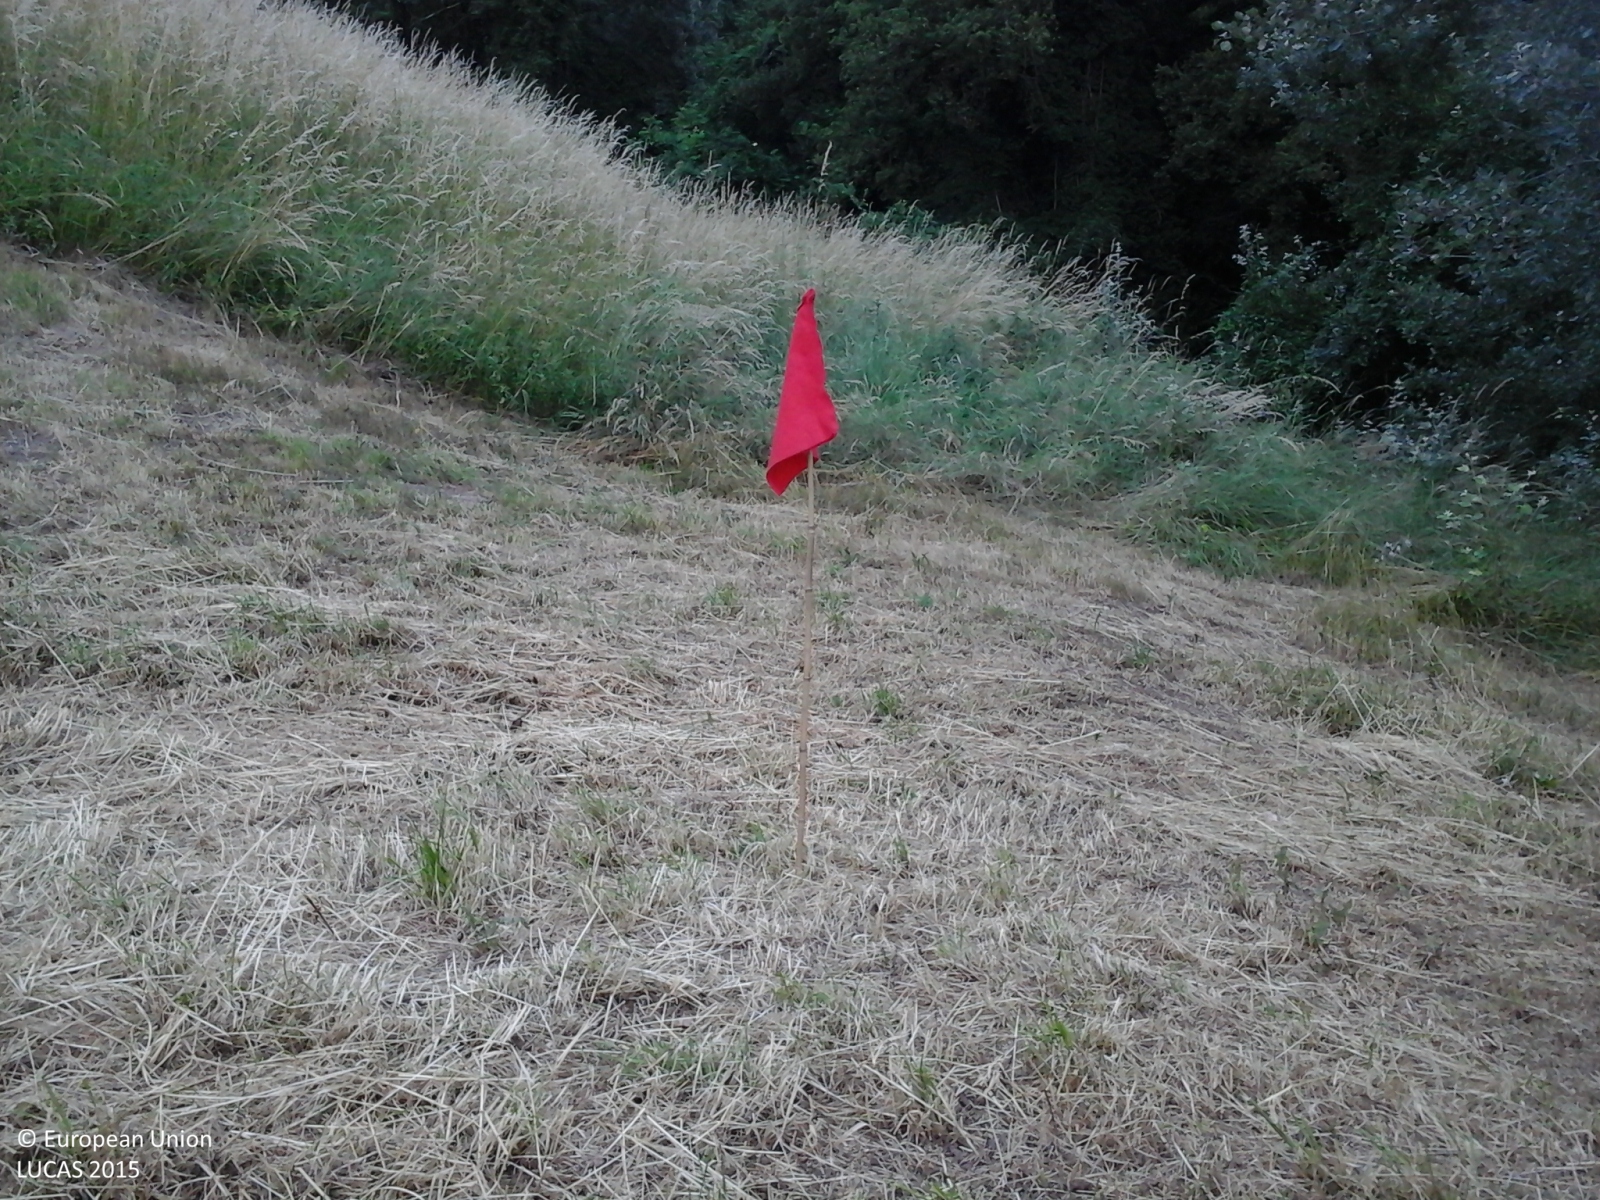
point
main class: Grassland
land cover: Grassland without tree/shrub cover
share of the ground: > 75 %
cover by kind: herbaceous plants 100 %
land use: Agriculture (excluding fallow land and kitchen gardens)
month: June
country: IT
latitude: 45.6273
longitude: 10.8324
